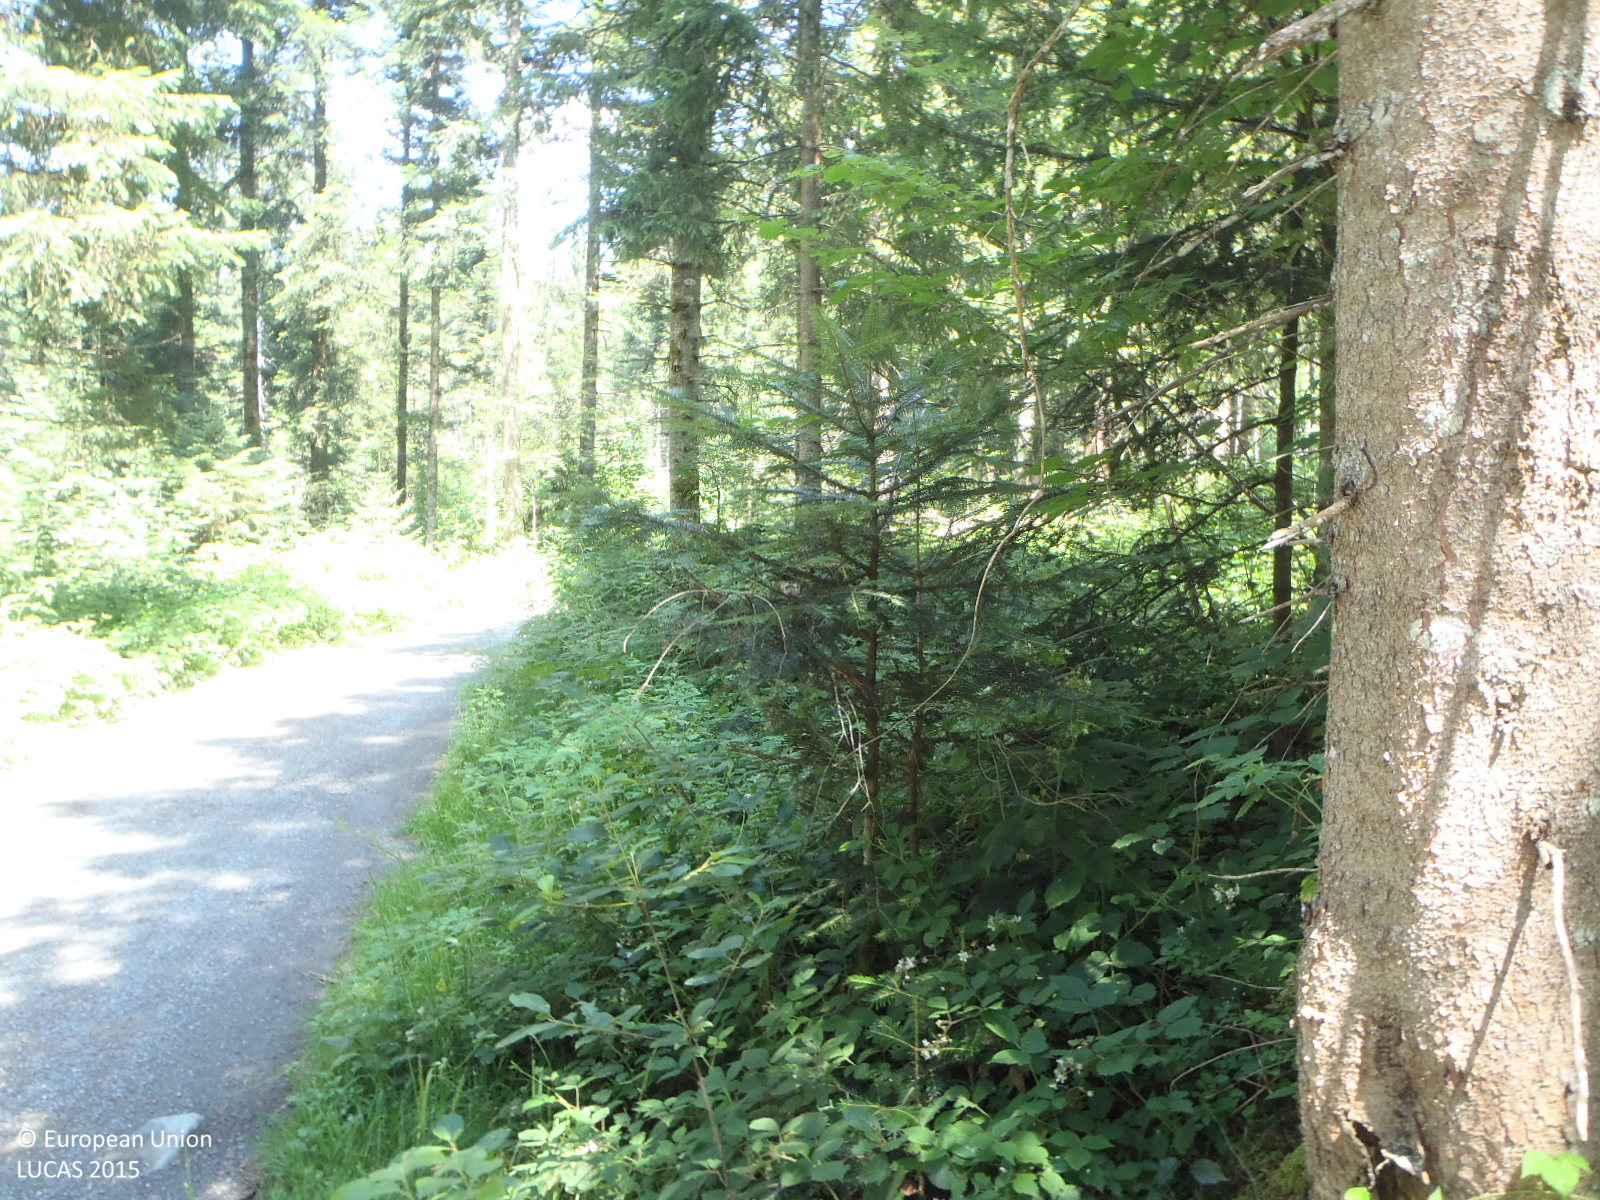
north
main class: Woodland
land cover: Other coniferous woodland
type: alpine coniferous forest
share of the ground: > 75 %
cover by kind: coniferous forest trees 75 %, broadleaved forest trees 25 %
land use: Forestry
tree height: > 5 m
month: July
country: AT
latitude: 47.4778
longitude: 12.3736
